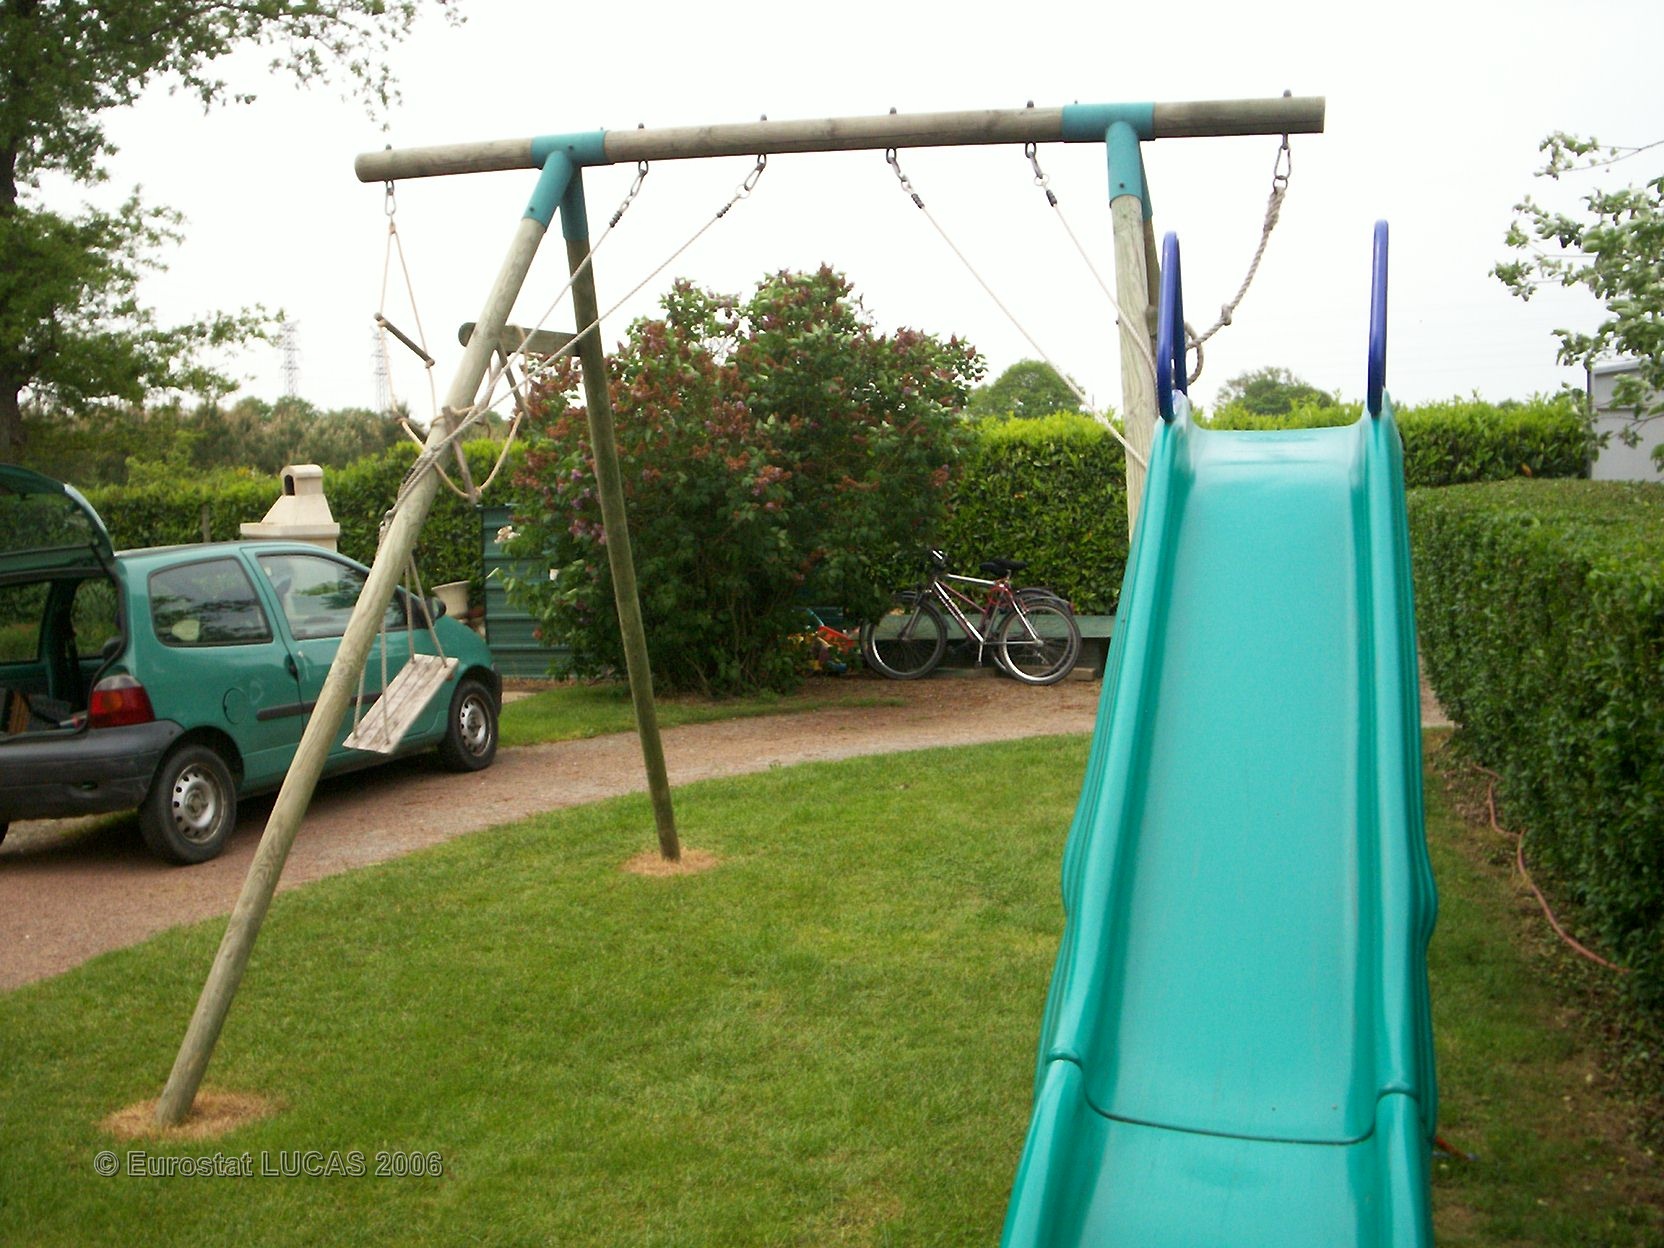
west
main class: Grassland
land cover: Grassland with sparse tree/shrub cover
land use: Kitchen garden
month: May
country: FR
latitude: 47.6812
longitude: -1.4322
